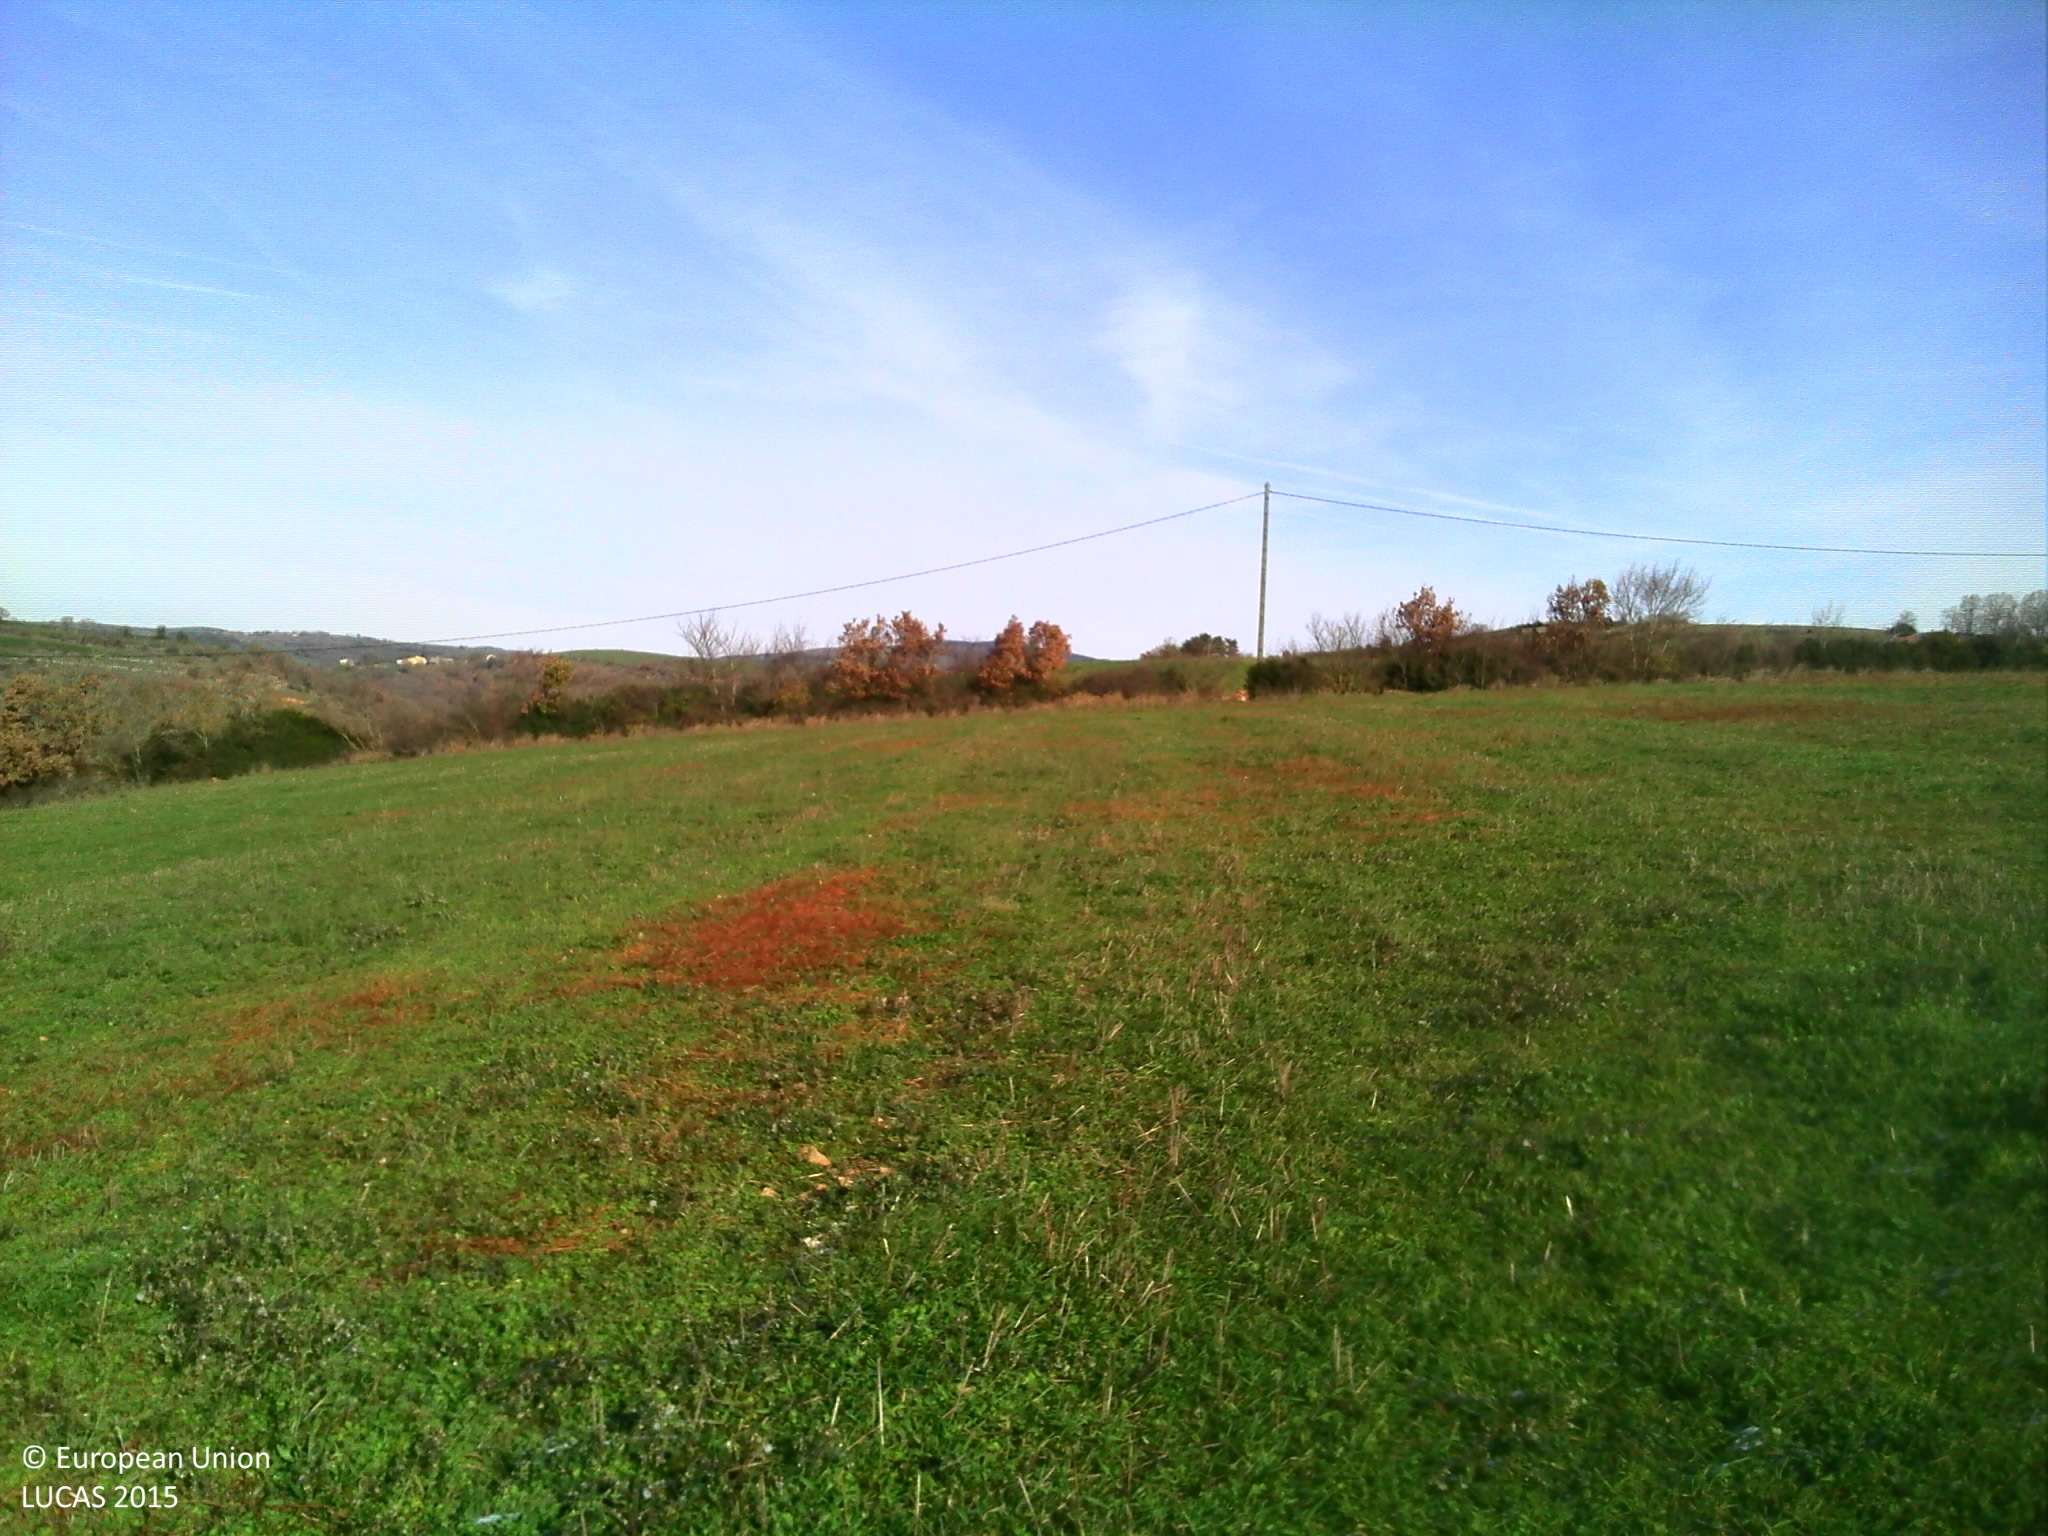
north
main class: Cropland
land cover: Temporary grasslands
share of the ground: > 75 %
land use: Agriculture (excluding fallow land and kitchen gardens)
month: November
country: FR
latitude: 44.2035
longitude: 2.9850
